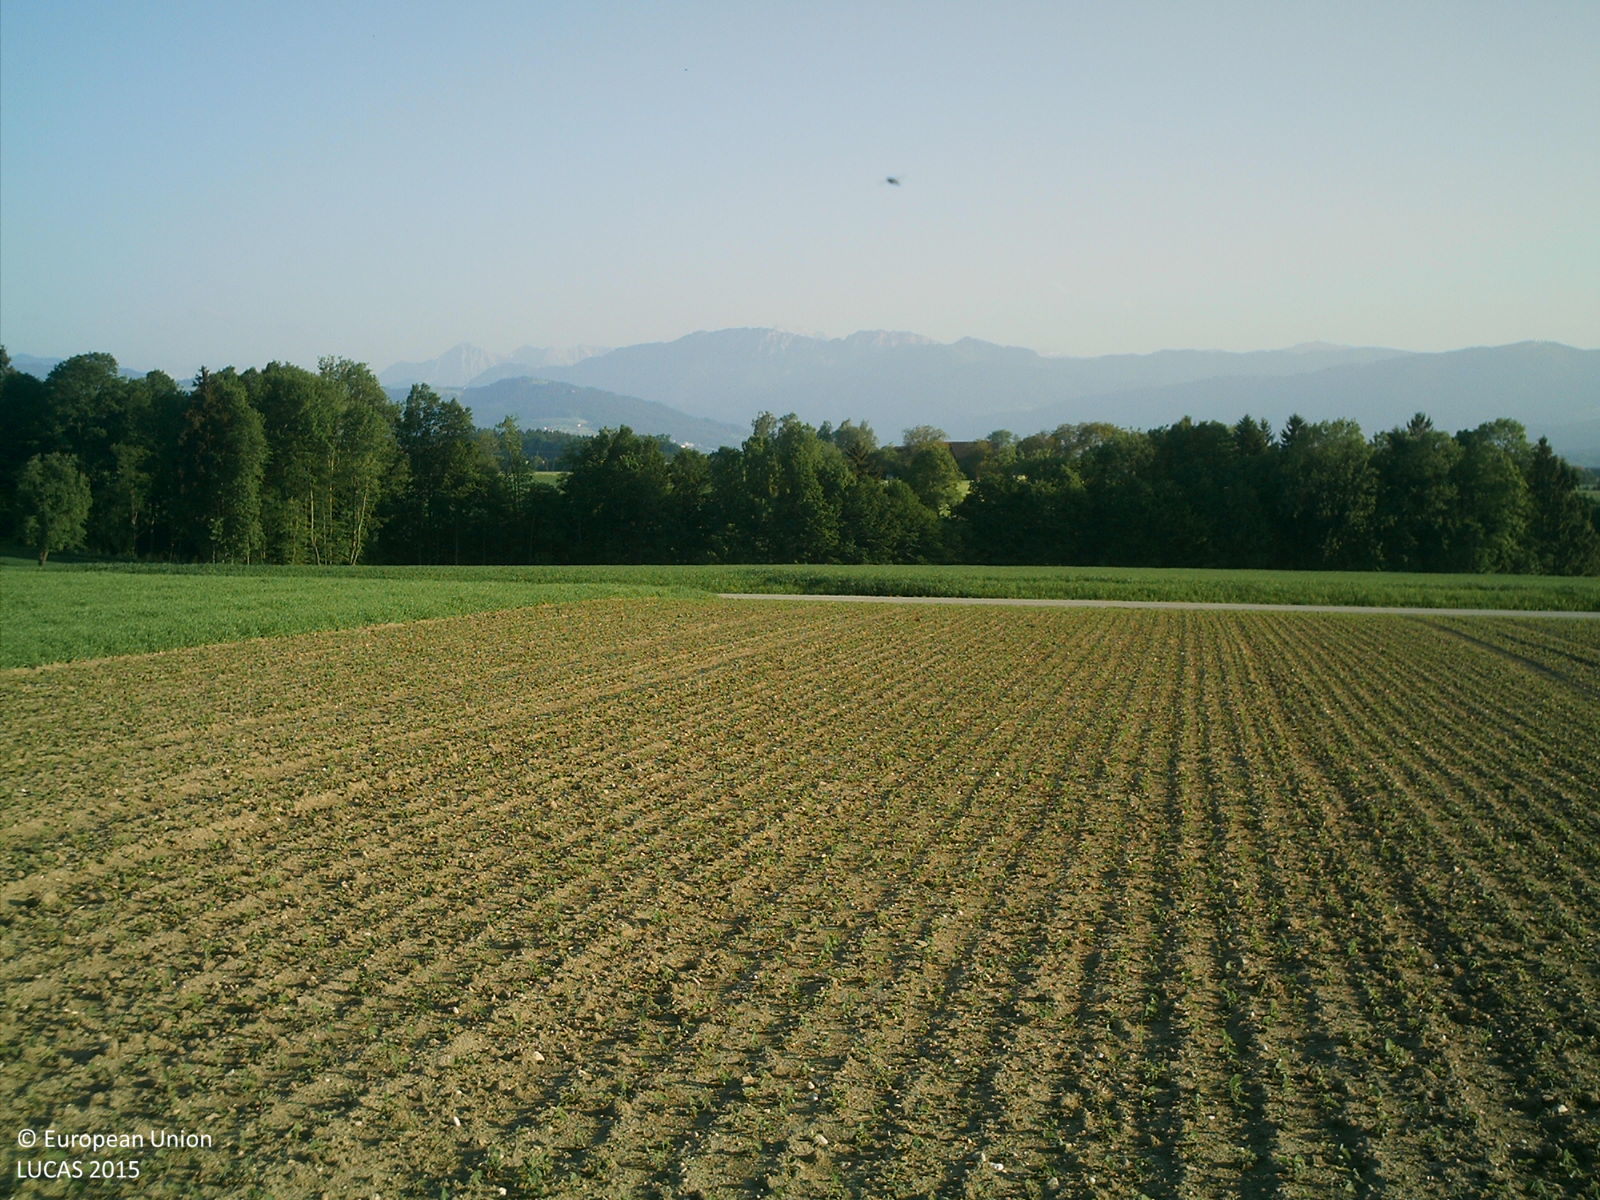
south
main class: Cropland
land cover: Soya
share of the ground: 50 - 75 %
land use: Agriculture (excluding fallow land and kitchen gardens)
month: May
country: AT
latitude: 48.0196
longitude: 14.1425
